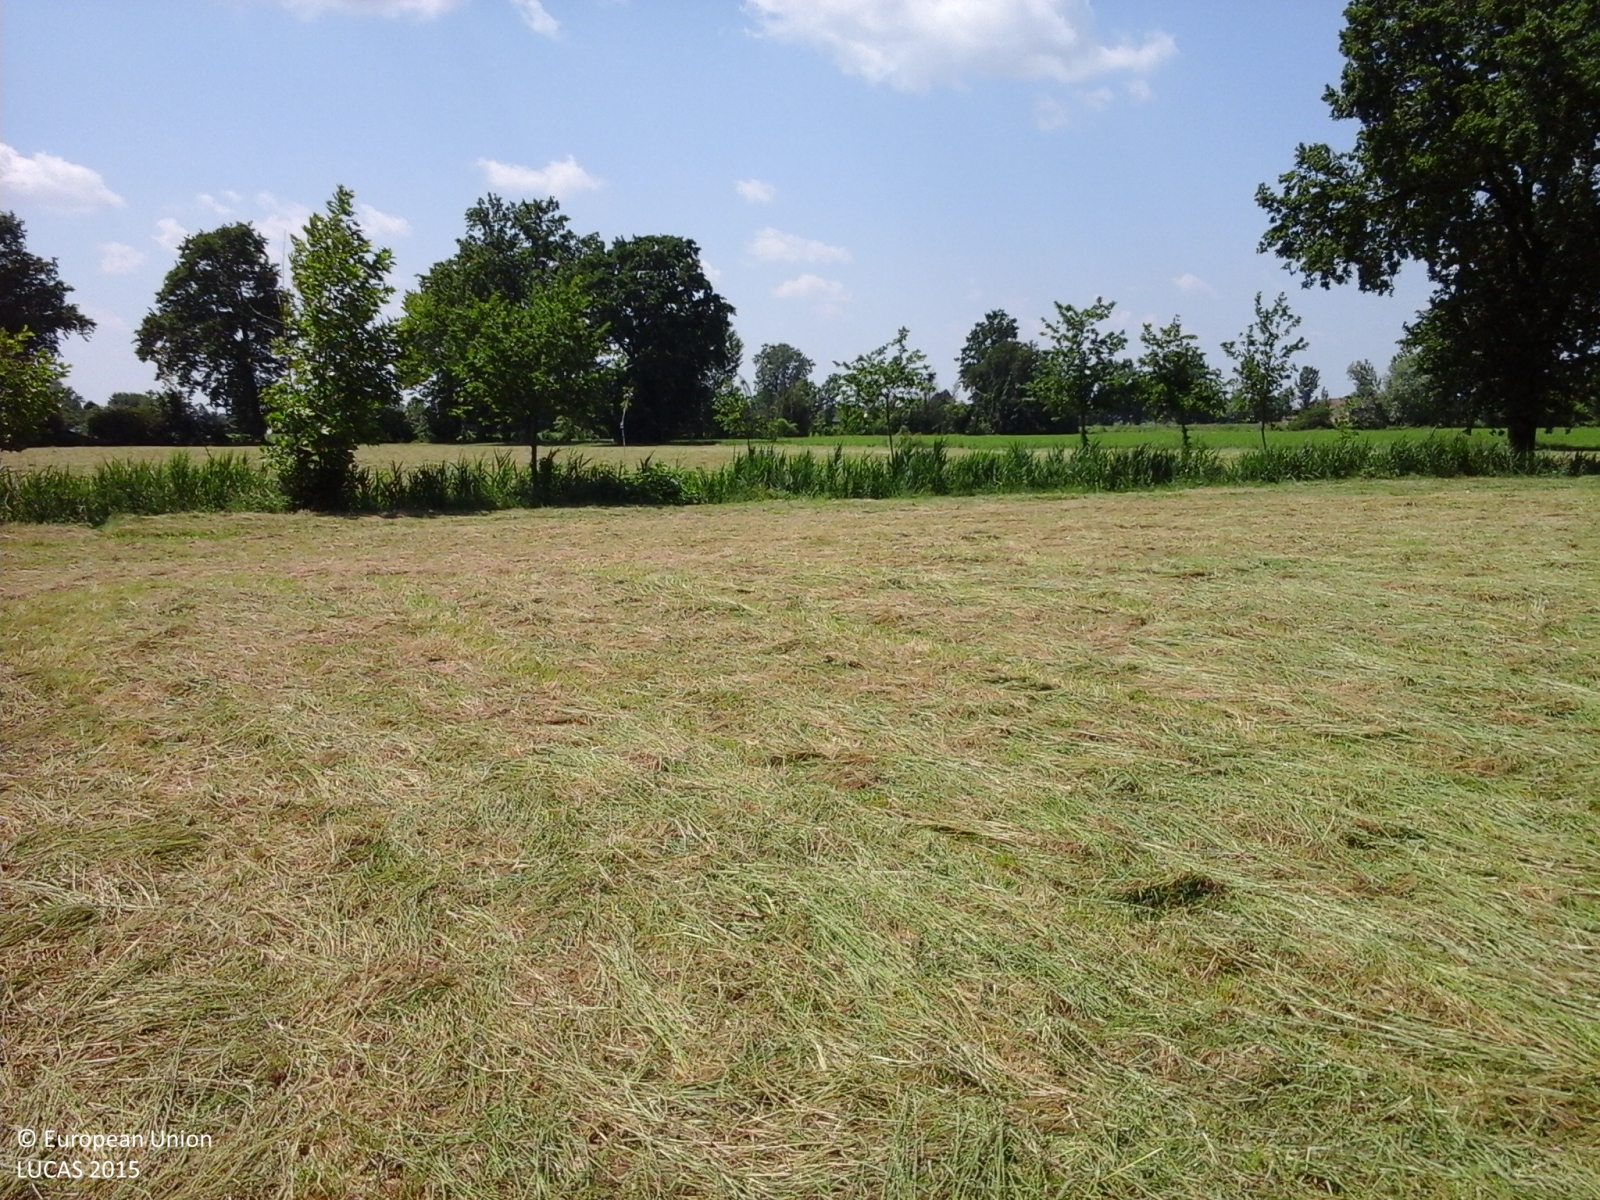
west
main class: Cropland
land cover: Temporary grasslands
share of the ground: > 75 %
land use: Agriculture (excluding fallow land and kitchen gardens)
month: May
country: IT
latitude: 45.3958
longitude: 9.6812
